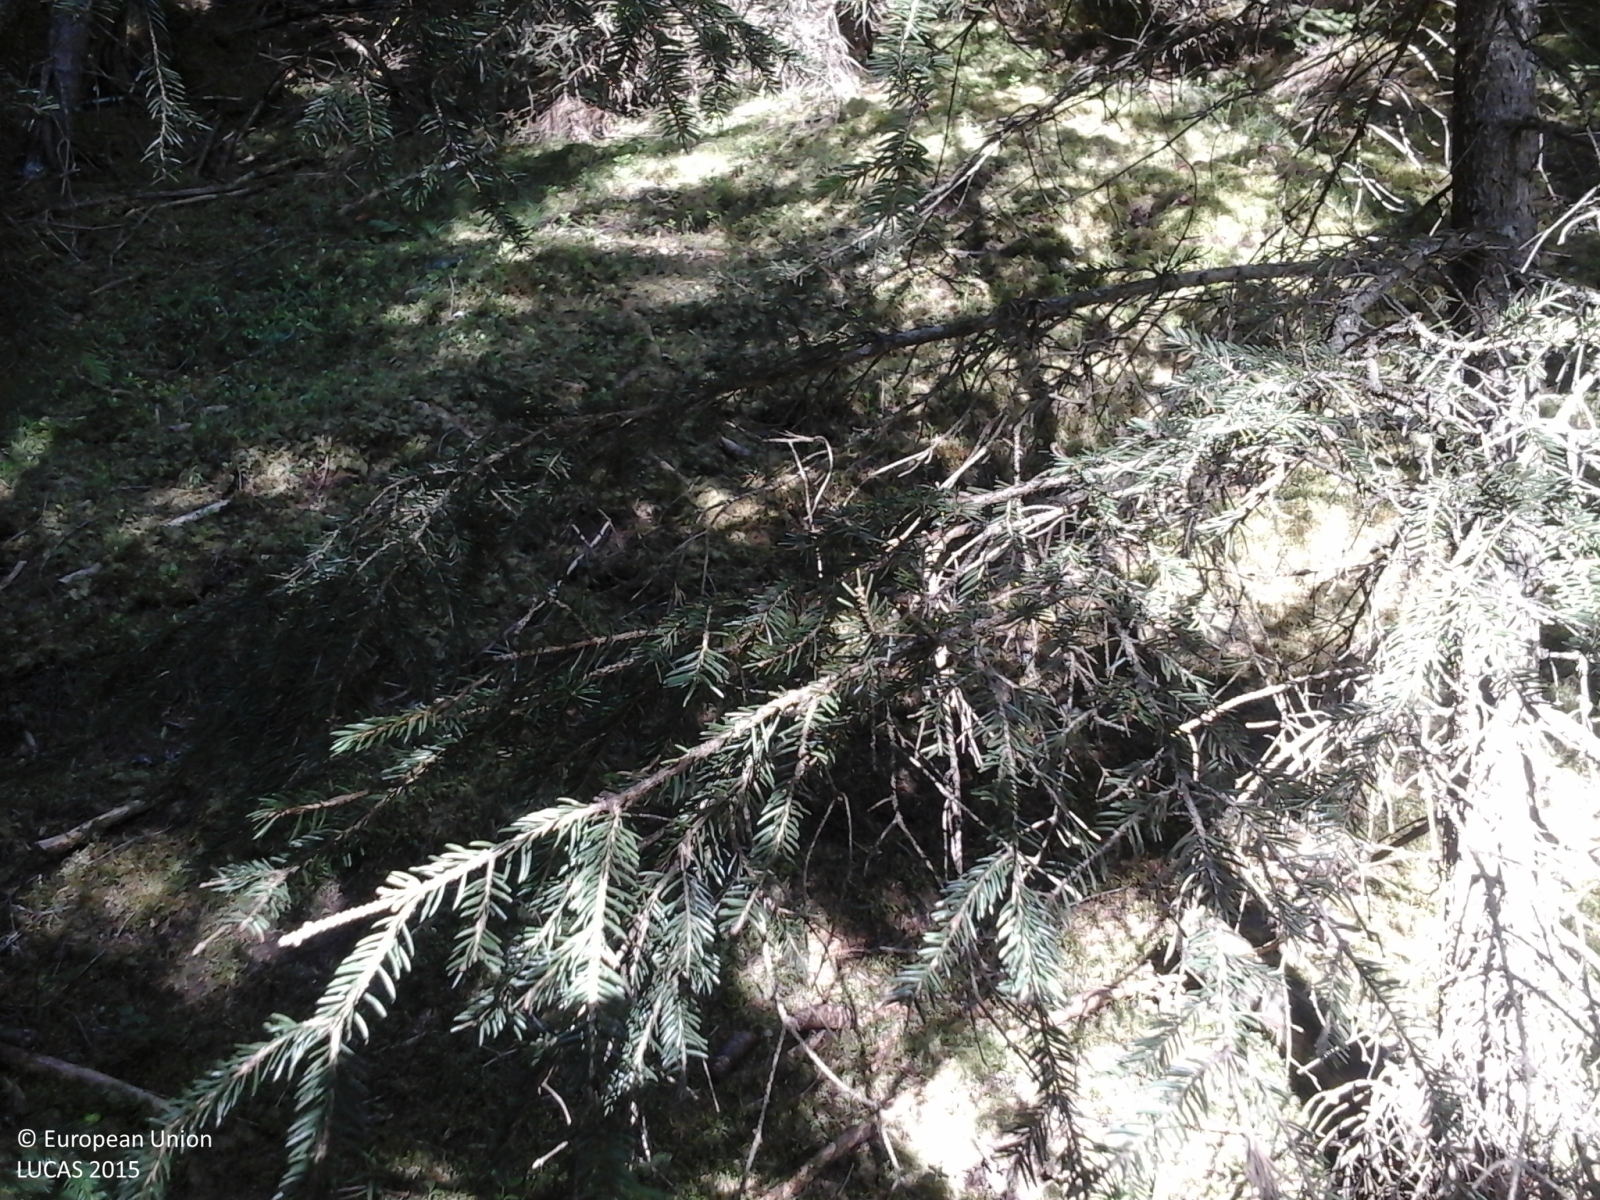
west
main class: Woodland
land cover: Spruce dominated coniferous woodland
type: alpine coniferous forest
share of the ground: > 75 %
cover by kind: coniferous forest trees 100 %
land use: Forestry
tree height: > 5 m
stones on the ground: 25 - 50 %
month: June
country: IT
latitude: 46.6994
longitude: 11.6068
